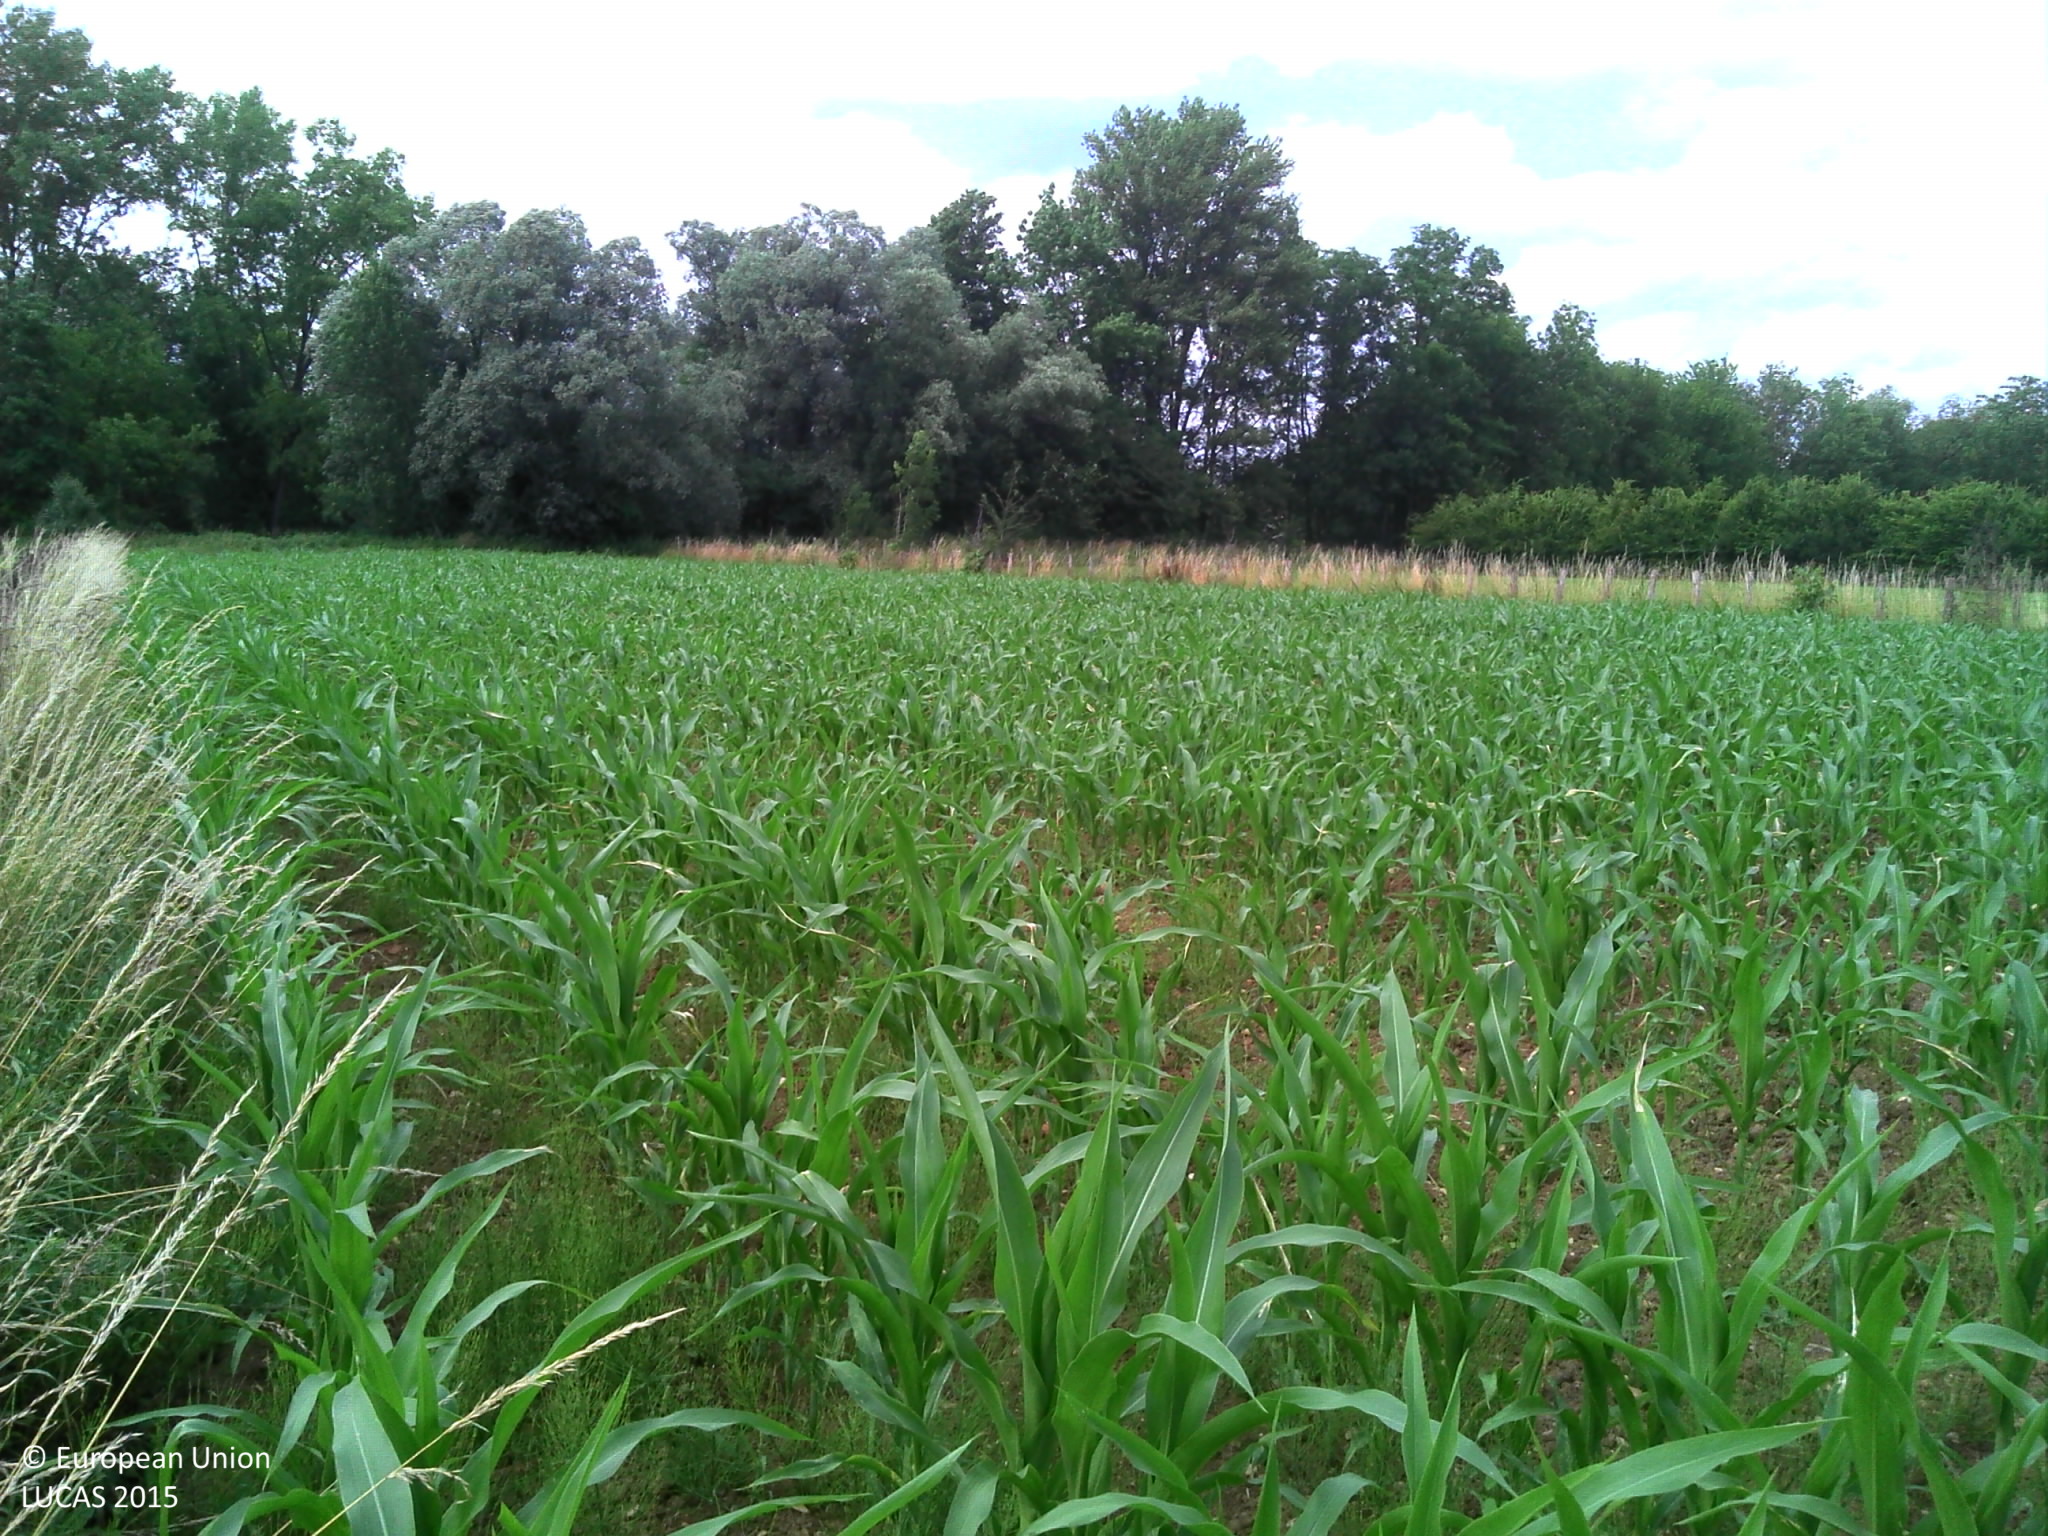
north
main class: Grassland
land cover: Grassland without tree/shrub cover
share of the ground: > 75 %
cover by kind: herbaceous plants 100 %
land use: Agriculture (excluding fallow land and kitchen gardens)
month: June
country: FR
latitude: 46.7430
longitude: 5.4866
